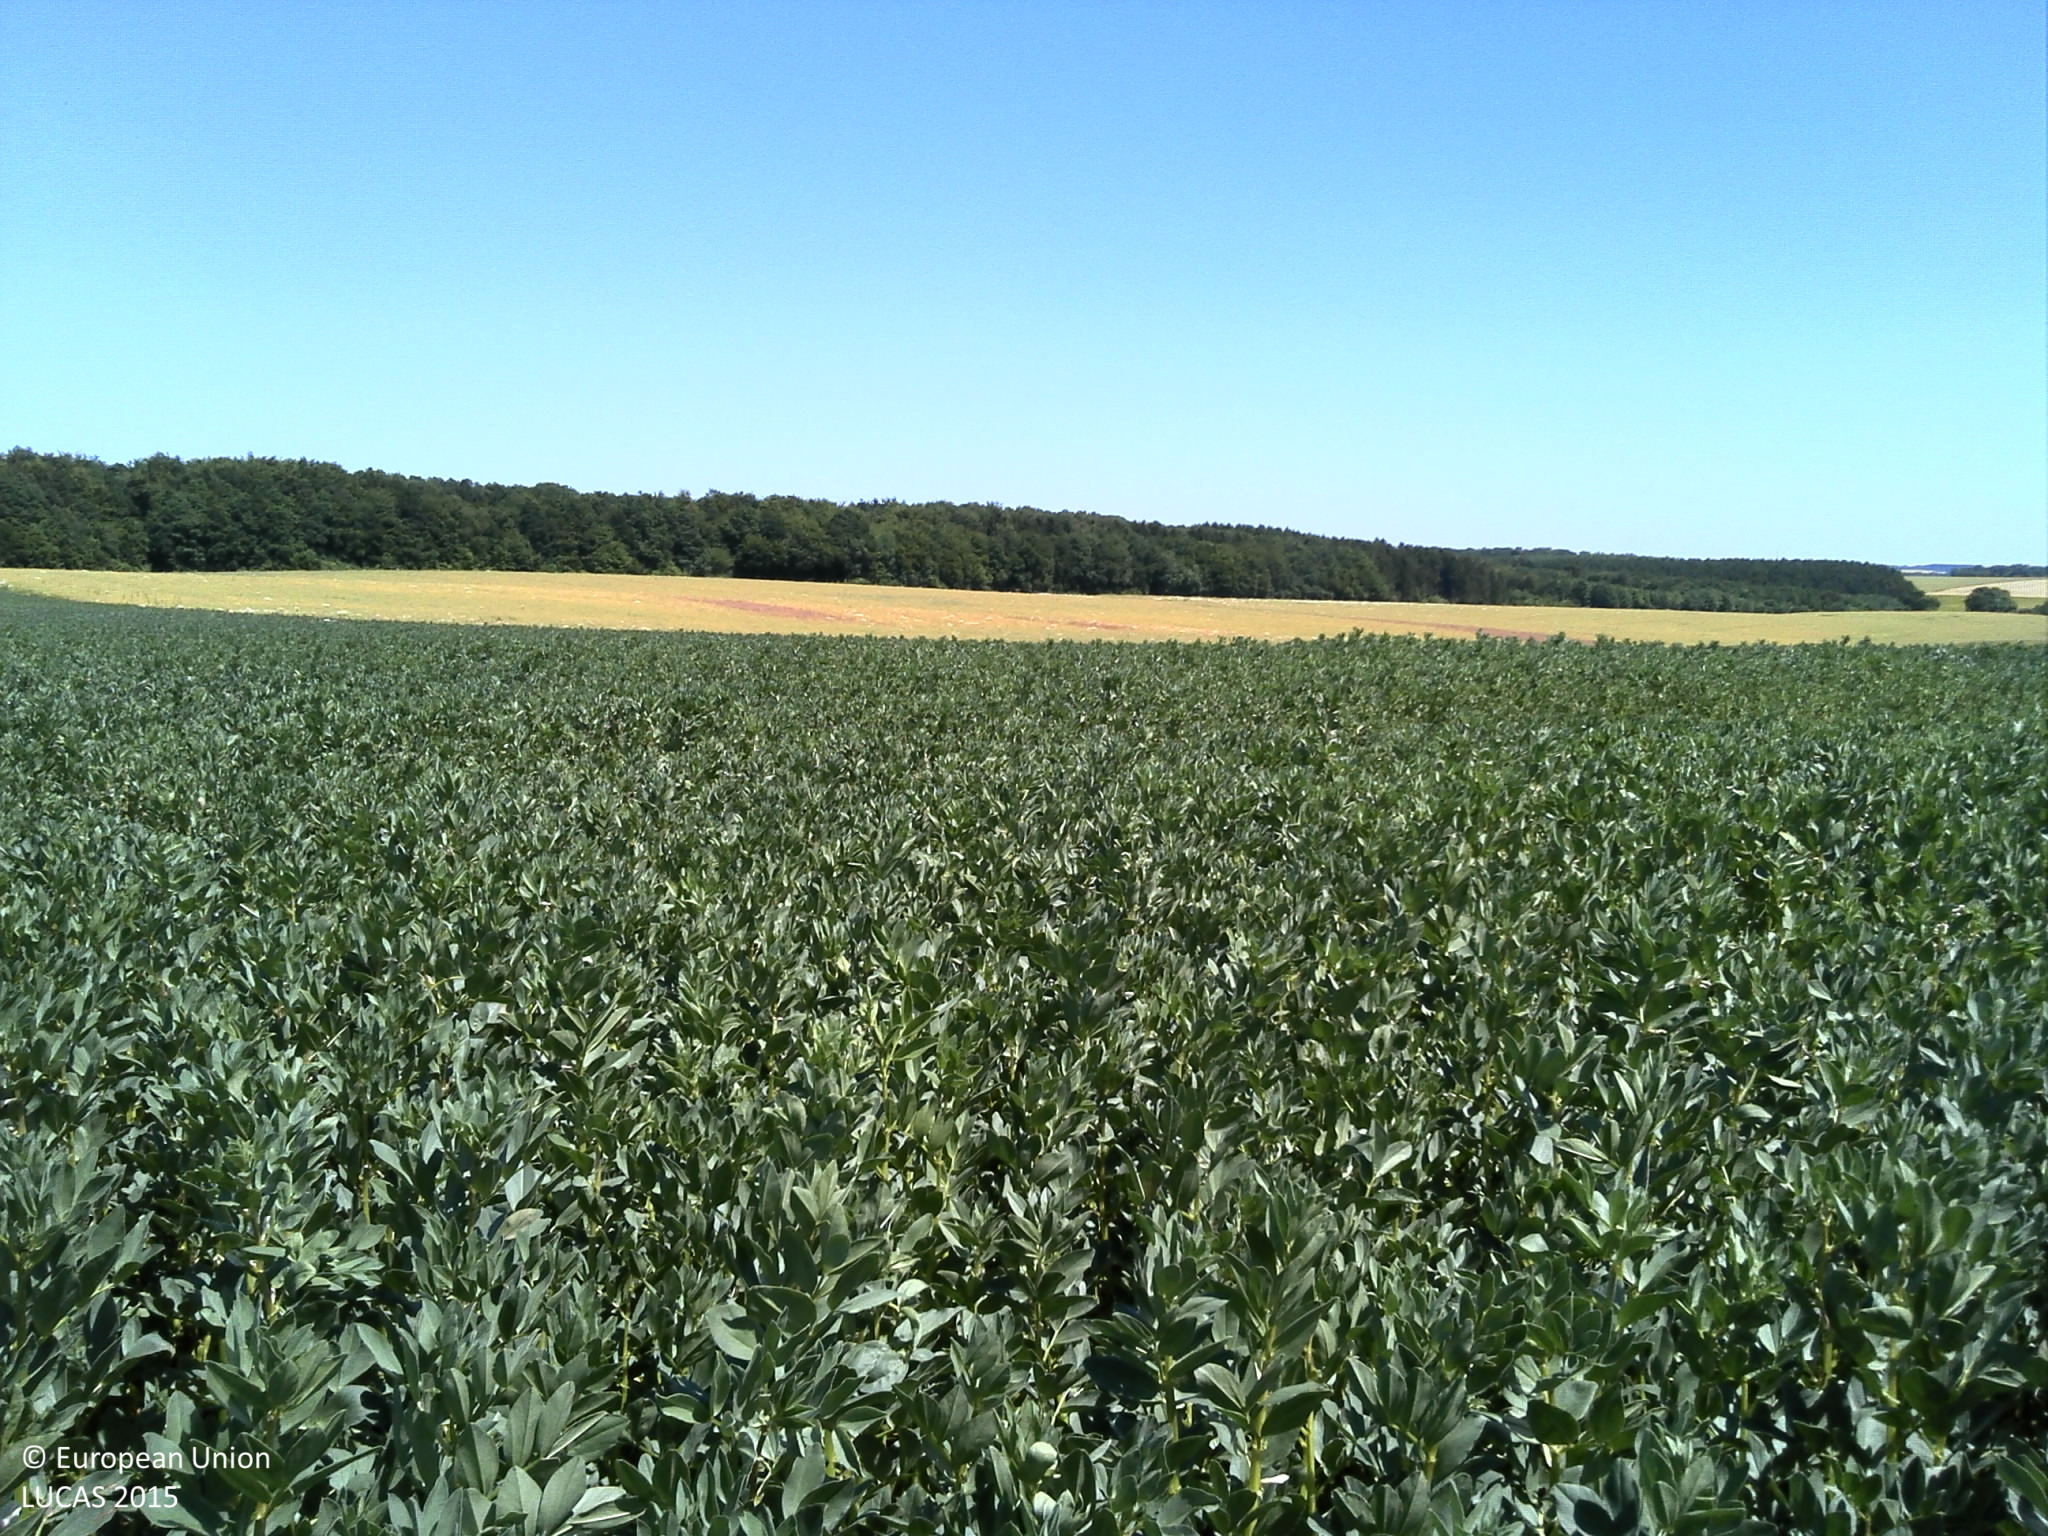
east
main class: Cropland
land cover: Dry pulses
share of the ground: > 75 %
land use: Agriculture (excluding fallow land and kitchen gardens)
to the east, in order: Dry pulses; Grassland without tree/shrub cover; Barley; Rape and turnip rape
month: June
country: FR
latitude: 49.4284
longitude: 5.9595
